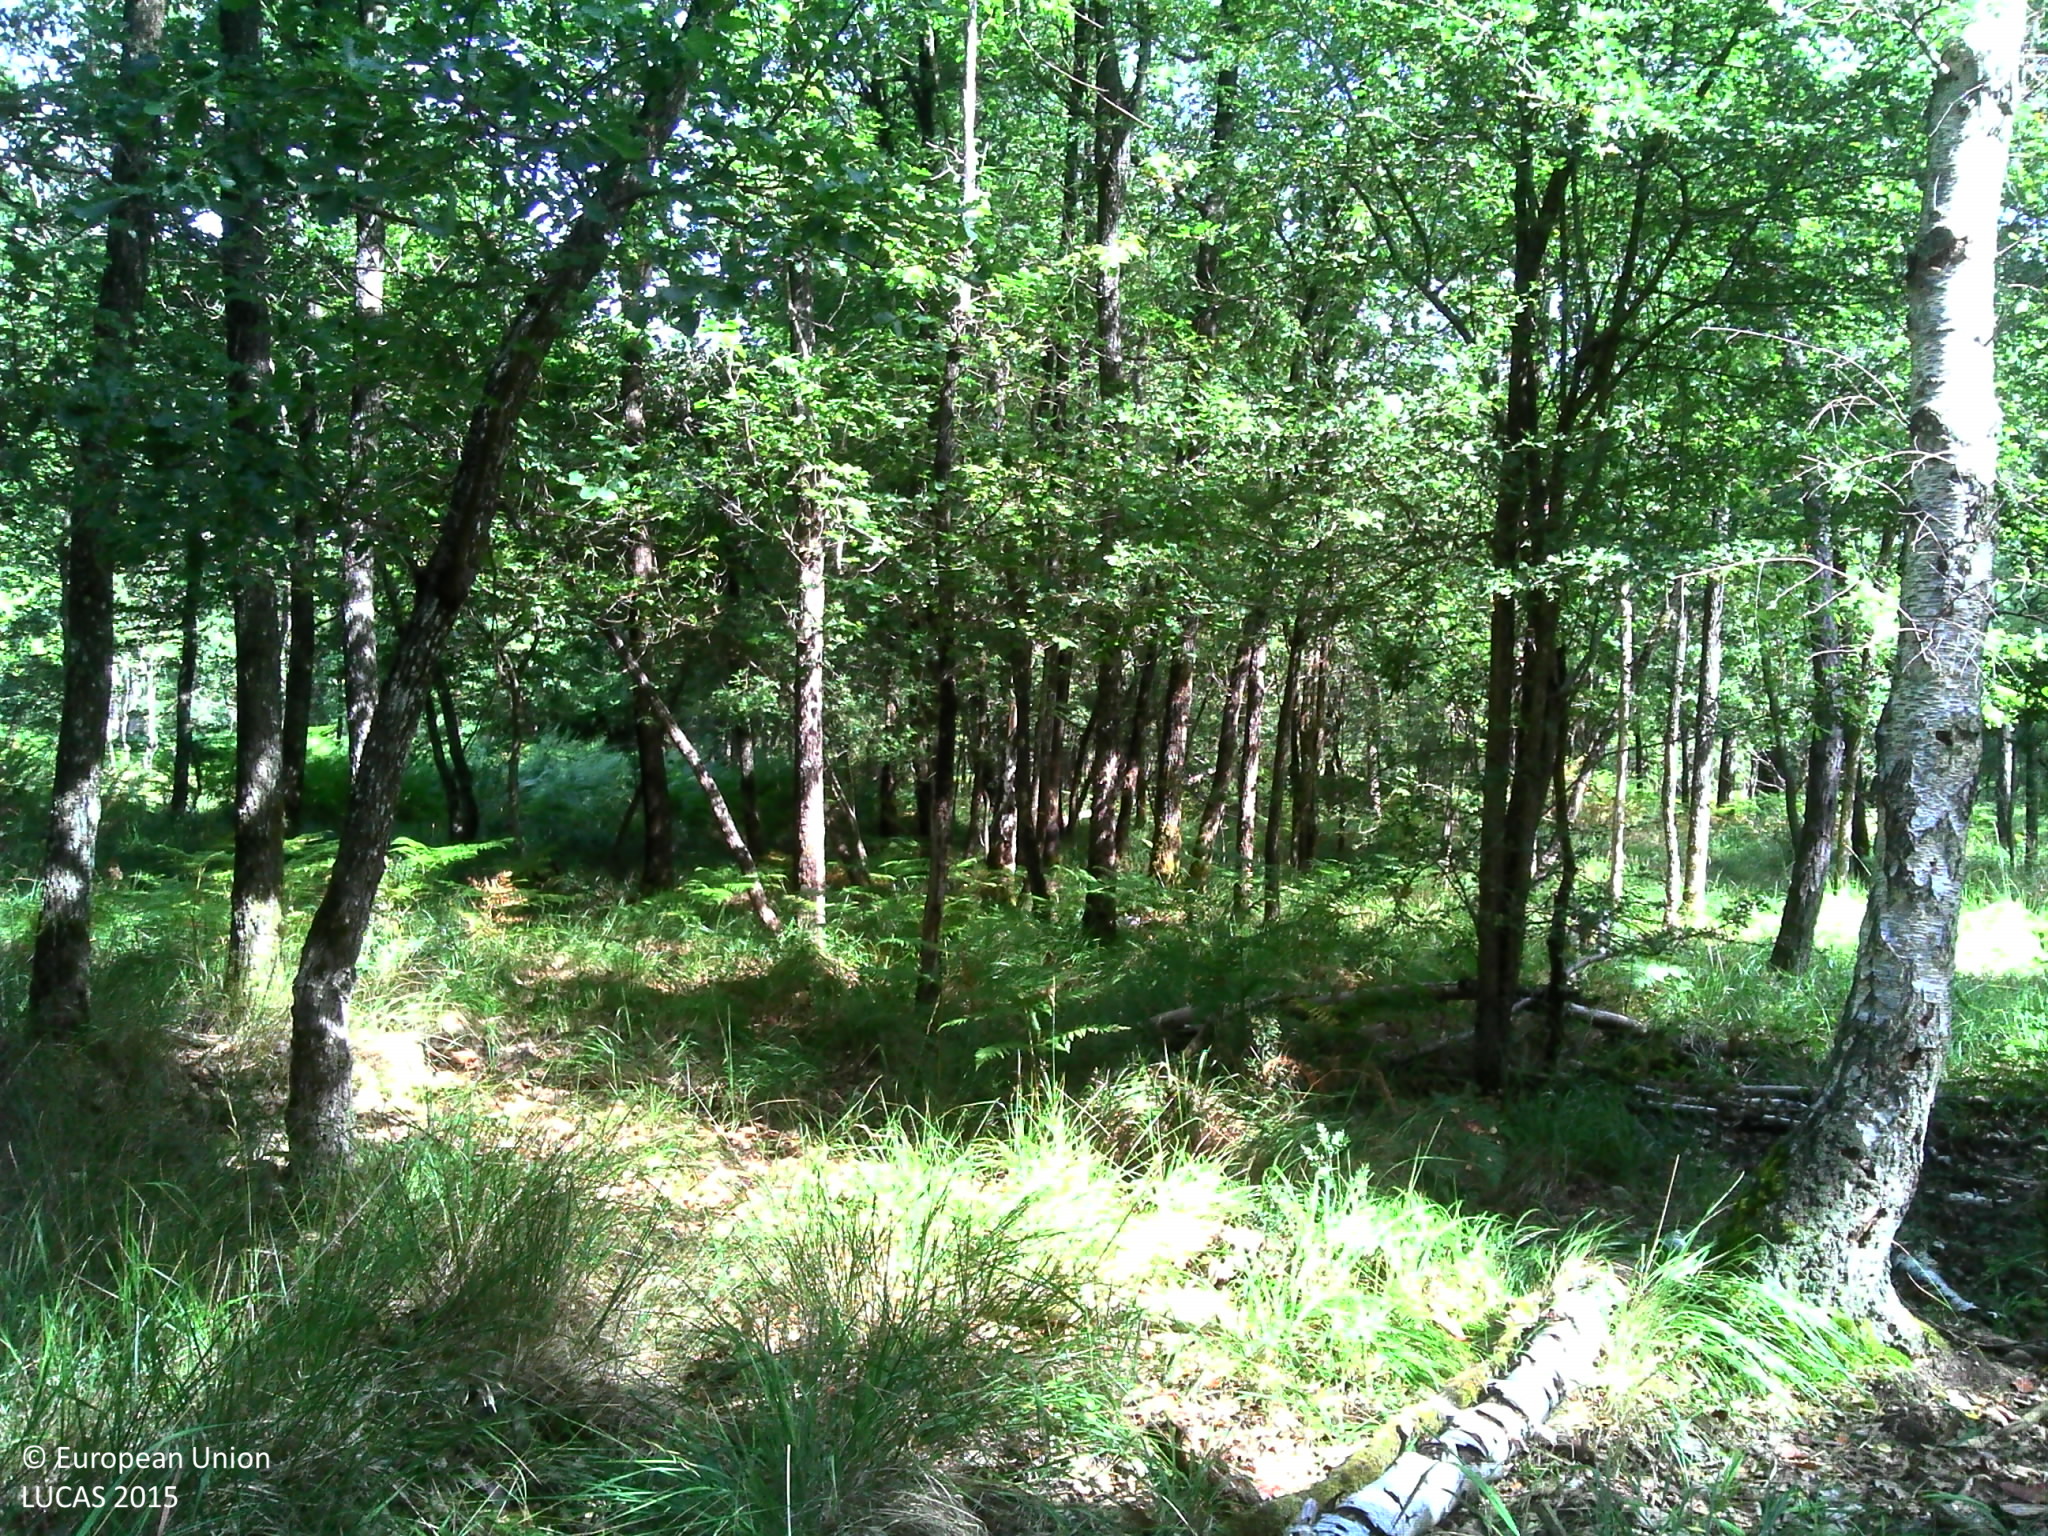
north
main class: Woodland
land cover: Pine dominated mixed woodland
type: hemiboreal forest and nemoral coniferous forest and mixed broadleaved-coniferous forest
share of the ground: > 75 %
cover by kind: herbaceous plants 45 %, broadleaved forest trees 30 %, coniferous forest trees 25 %
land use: Forestry
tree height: > 5 m
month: August
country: FR
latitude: 48.3797
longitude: 2.7132
